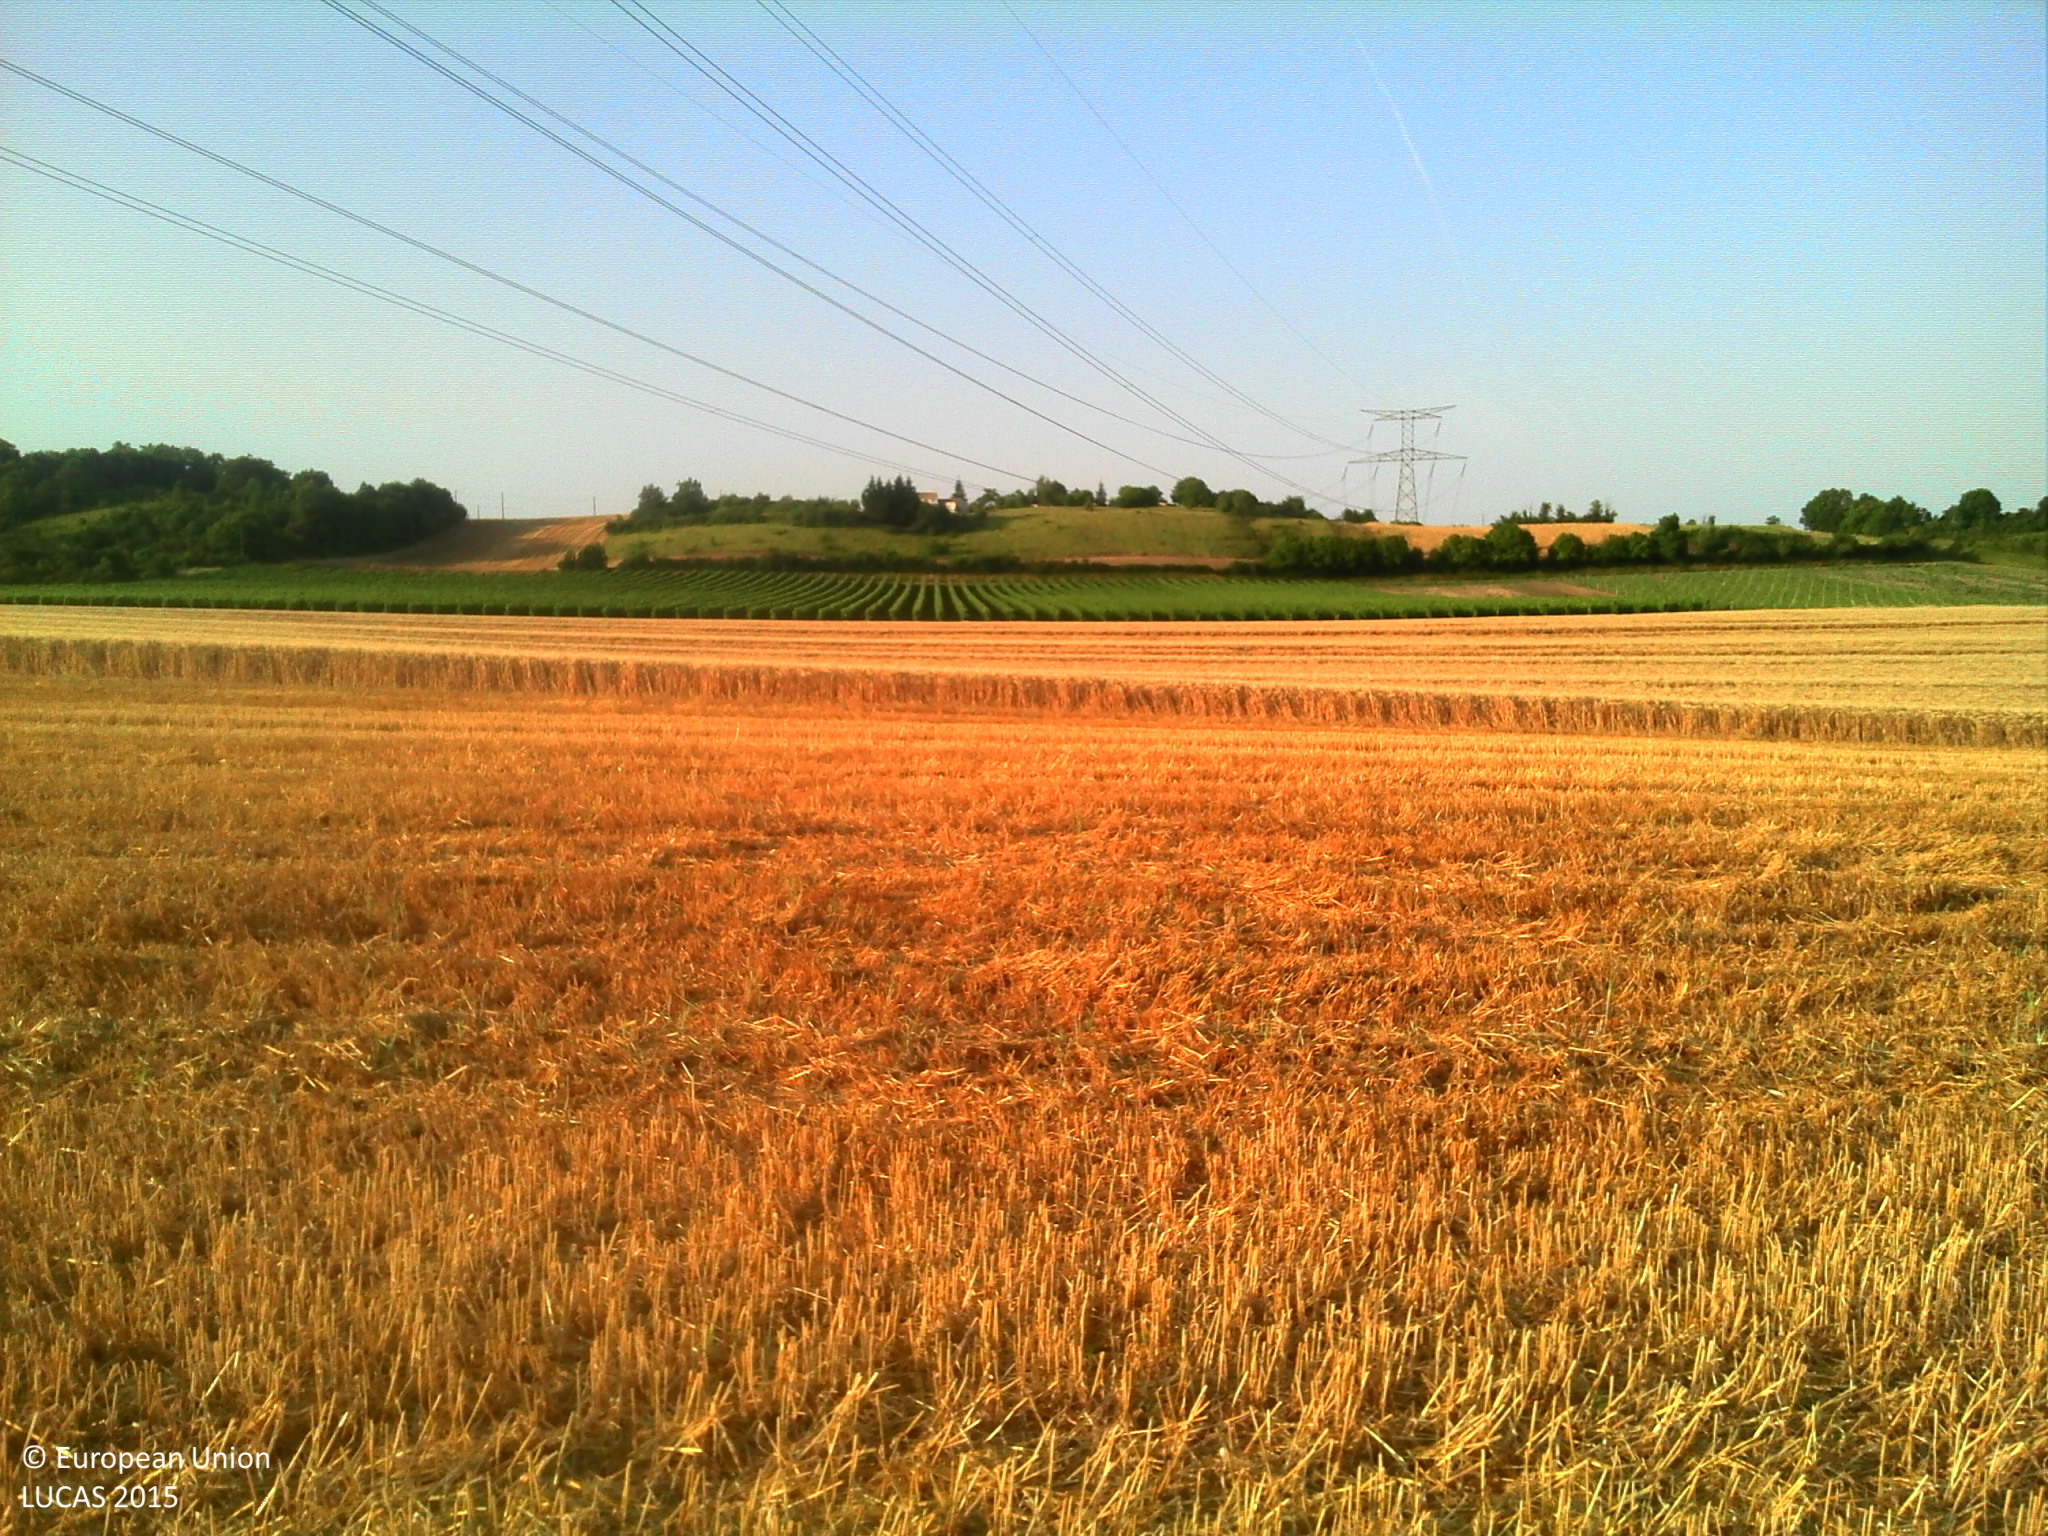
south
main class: Cropland
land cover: Durum wheat
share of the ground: > 75 %
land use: Agriculture (excluding fallow land and kitchen gardens)
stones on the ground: < 10 %
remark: Harvested field
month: July
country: FR
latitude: 45.3657
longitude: -0.6317
